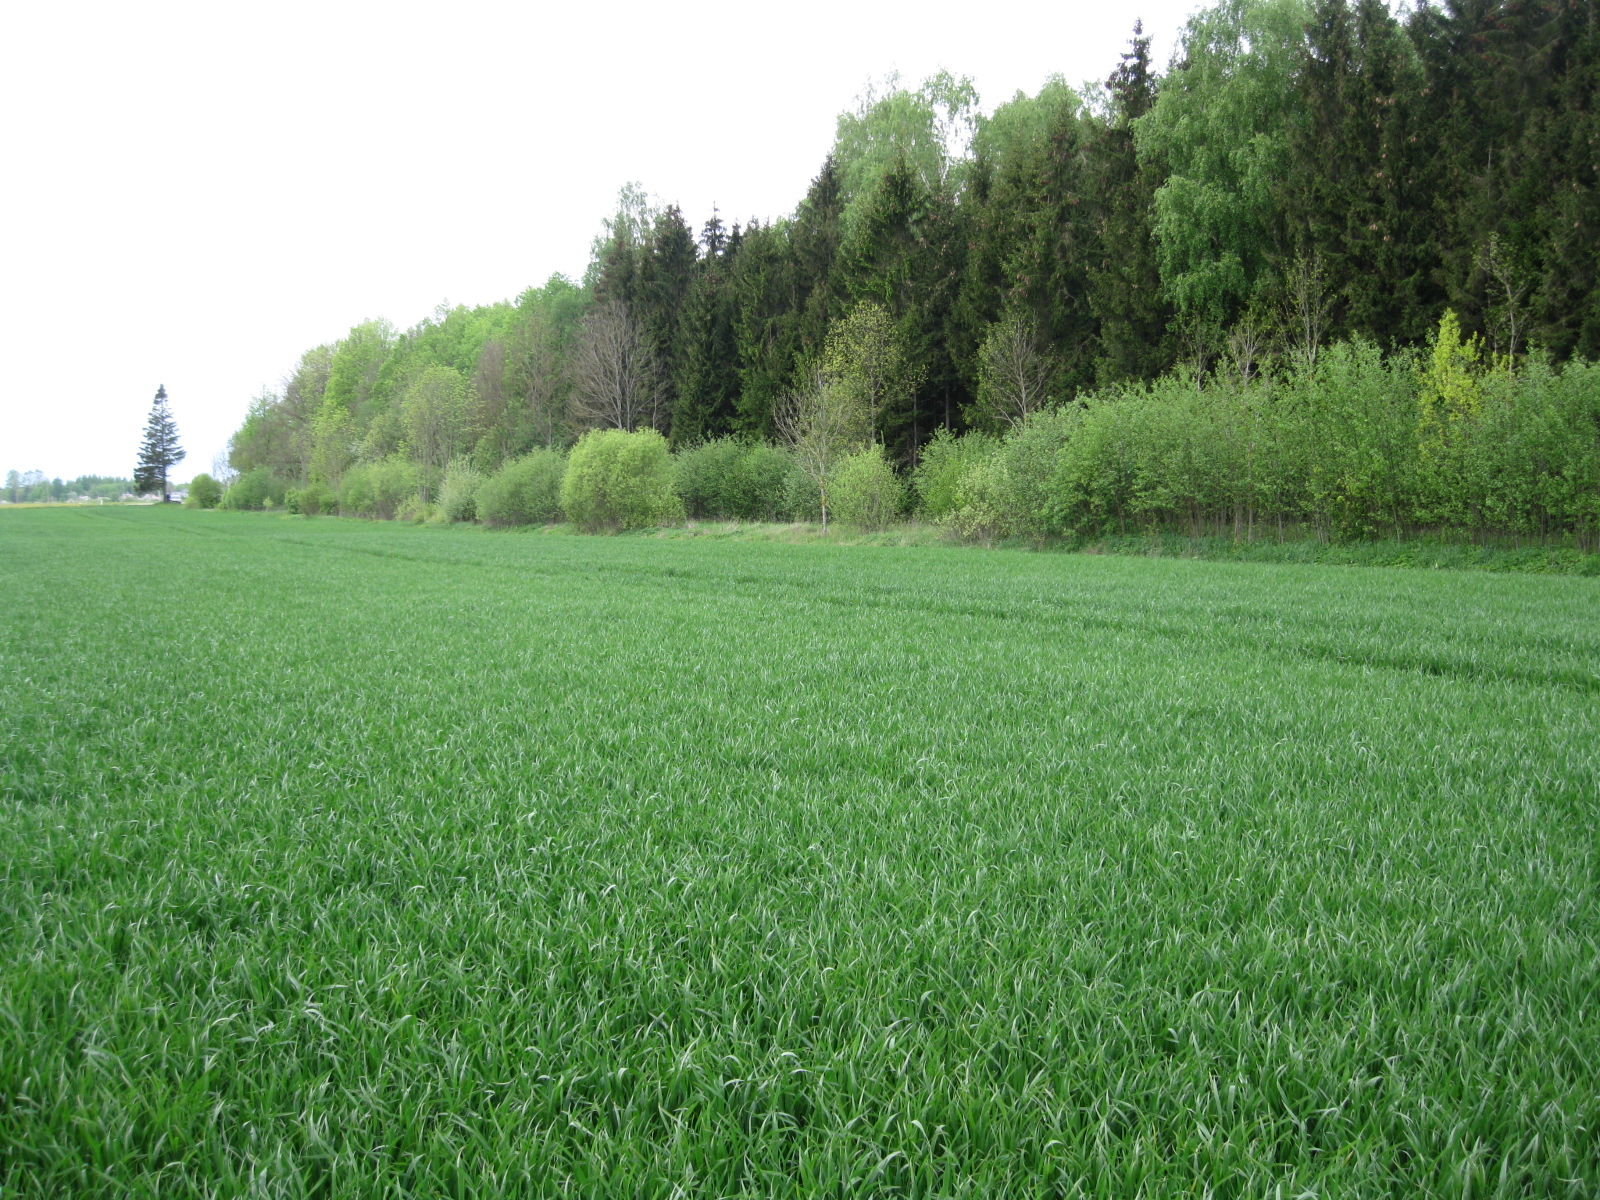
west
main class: Cropland
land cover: Common wheat
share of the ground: > 75 %
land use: Agriculture (excluding fallow land and kitchen gardens)
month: May
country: LT
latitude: 56.2311
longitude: 23.3822
